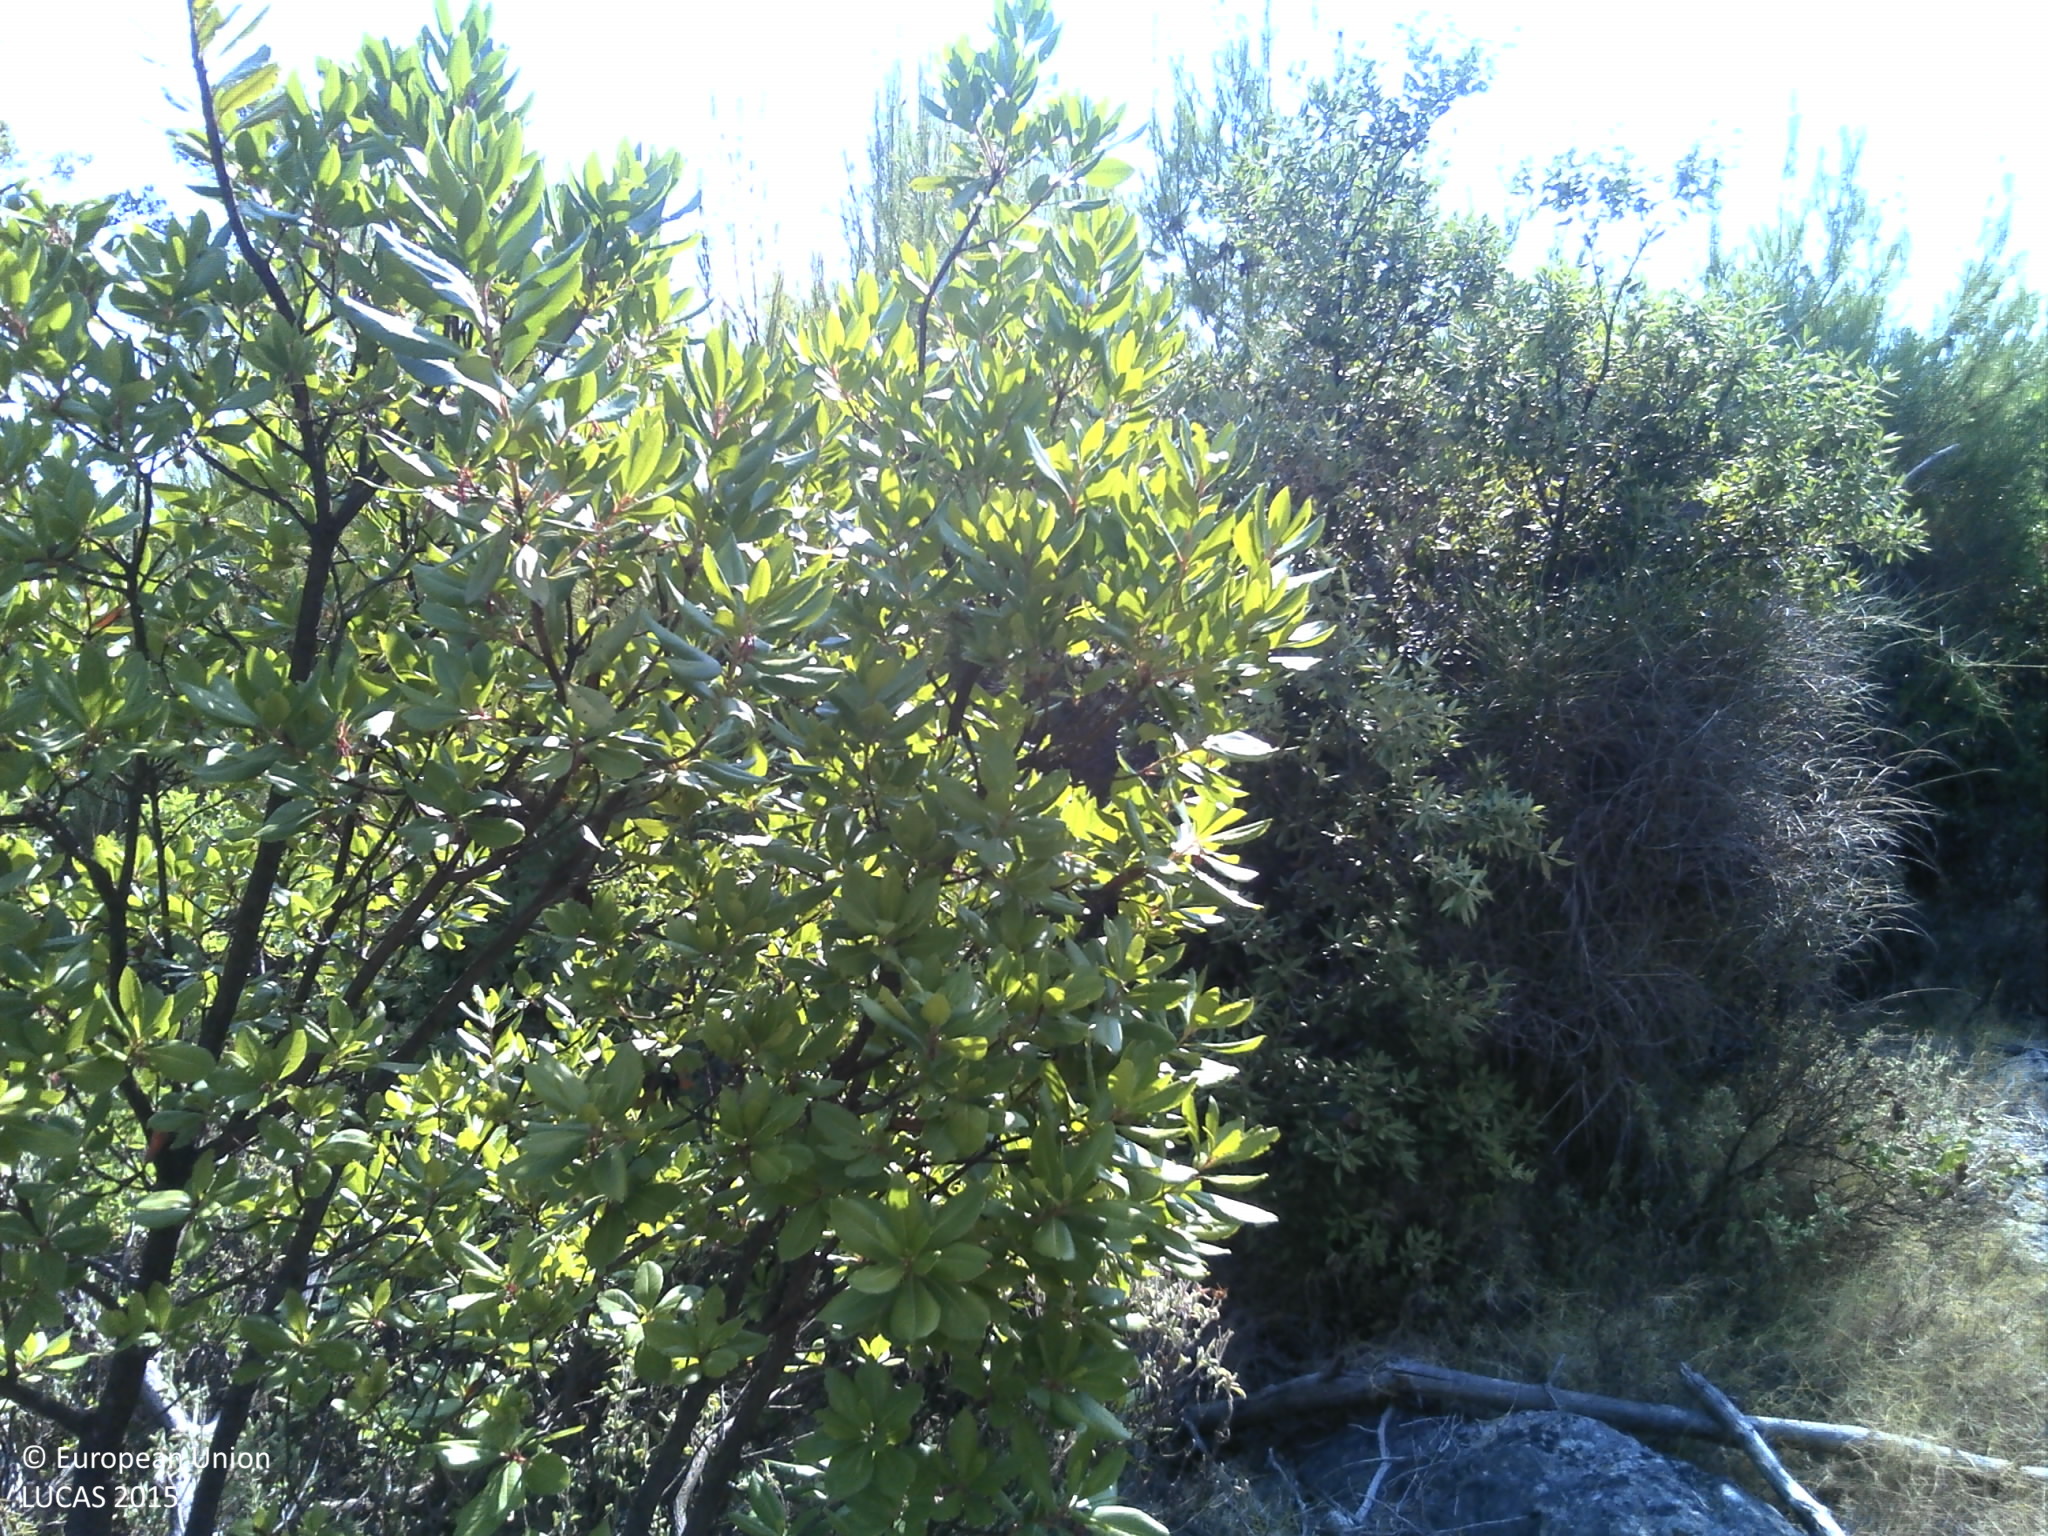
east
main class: Shrubland
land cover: Shrubland with sparse tree cover
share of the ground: > 75 %
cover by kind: shrubs 75 %, herbaceous plants 10 %, coniferous forest trees 5 %, consolidated bare surface 5 %, unconsolidated bare surface 5 %
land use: Semi-natural and natural areas not in use
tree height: > 5 m
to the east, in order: Shrubland with sparse tree cover; Dry stone walls; Shrubland with sparse tree cover; Pine dominated coniferous woodland; Dry stone walls; Pine dominated coniferous woodland; Shrubland with sparse tree cover
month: August
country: HR
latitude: 43.1650
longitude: 16.5698
